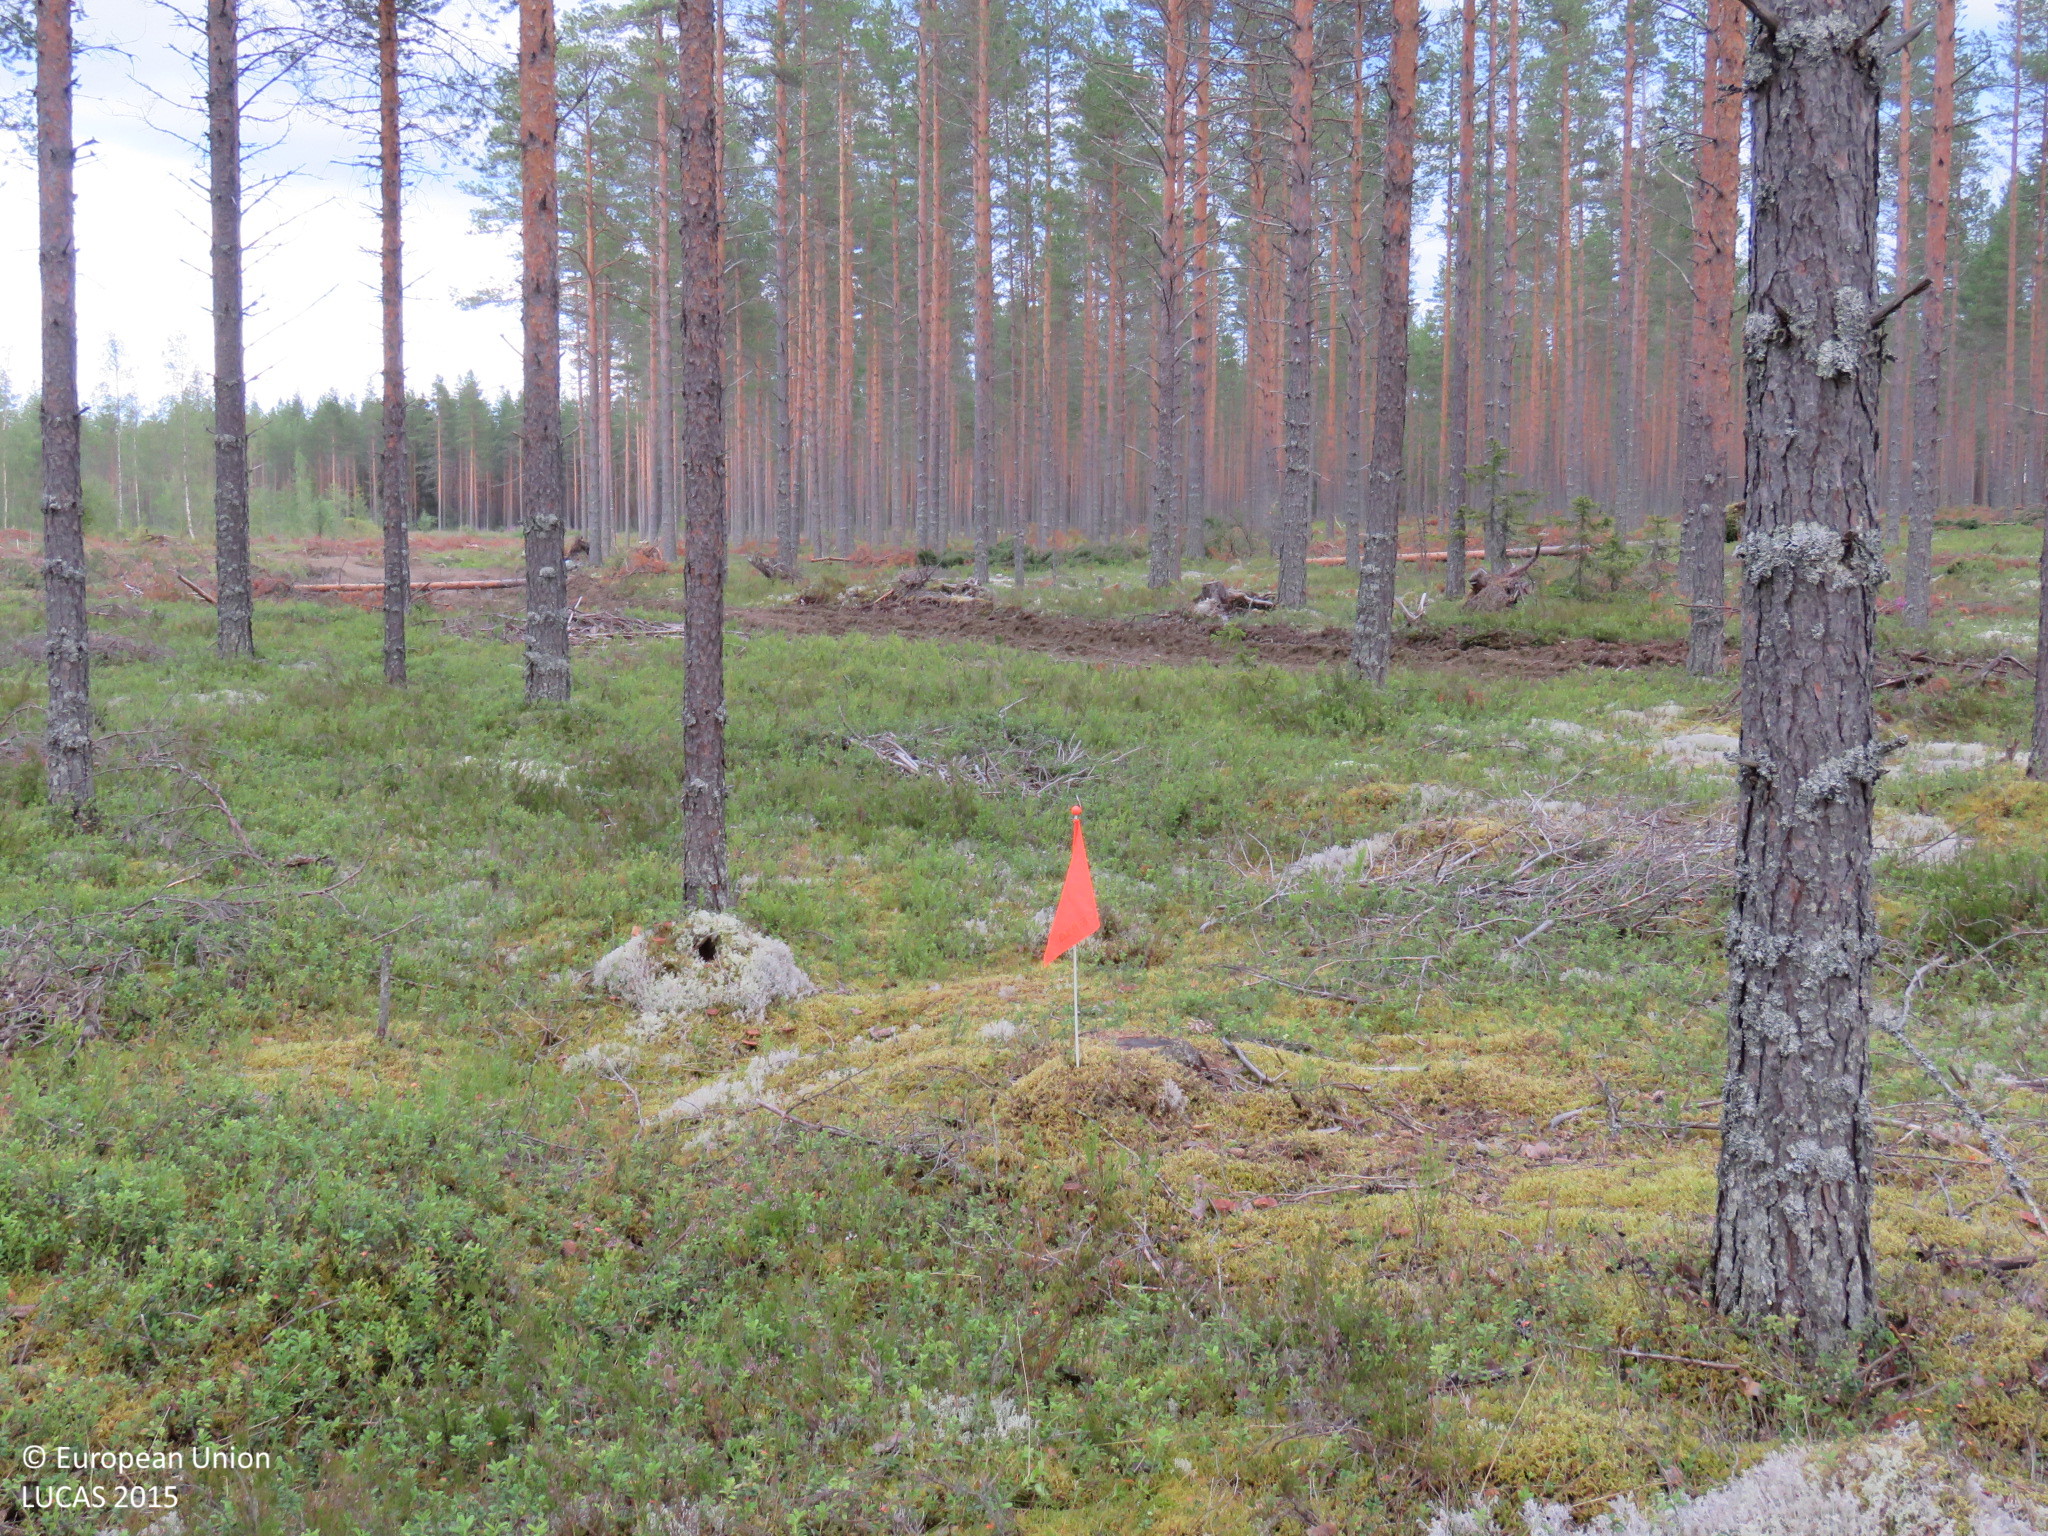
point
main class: Woodland
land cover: Pine dominated coniferous woodland
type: boreal forest
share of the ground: 50 - 75 %
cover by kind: coniferous forest trees 50 %, shrubs 40 %, lichens and mosses 10 %
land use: Forestry
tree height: > 5 m
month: July
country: FI
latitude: 64.7299
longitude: 26.5089
